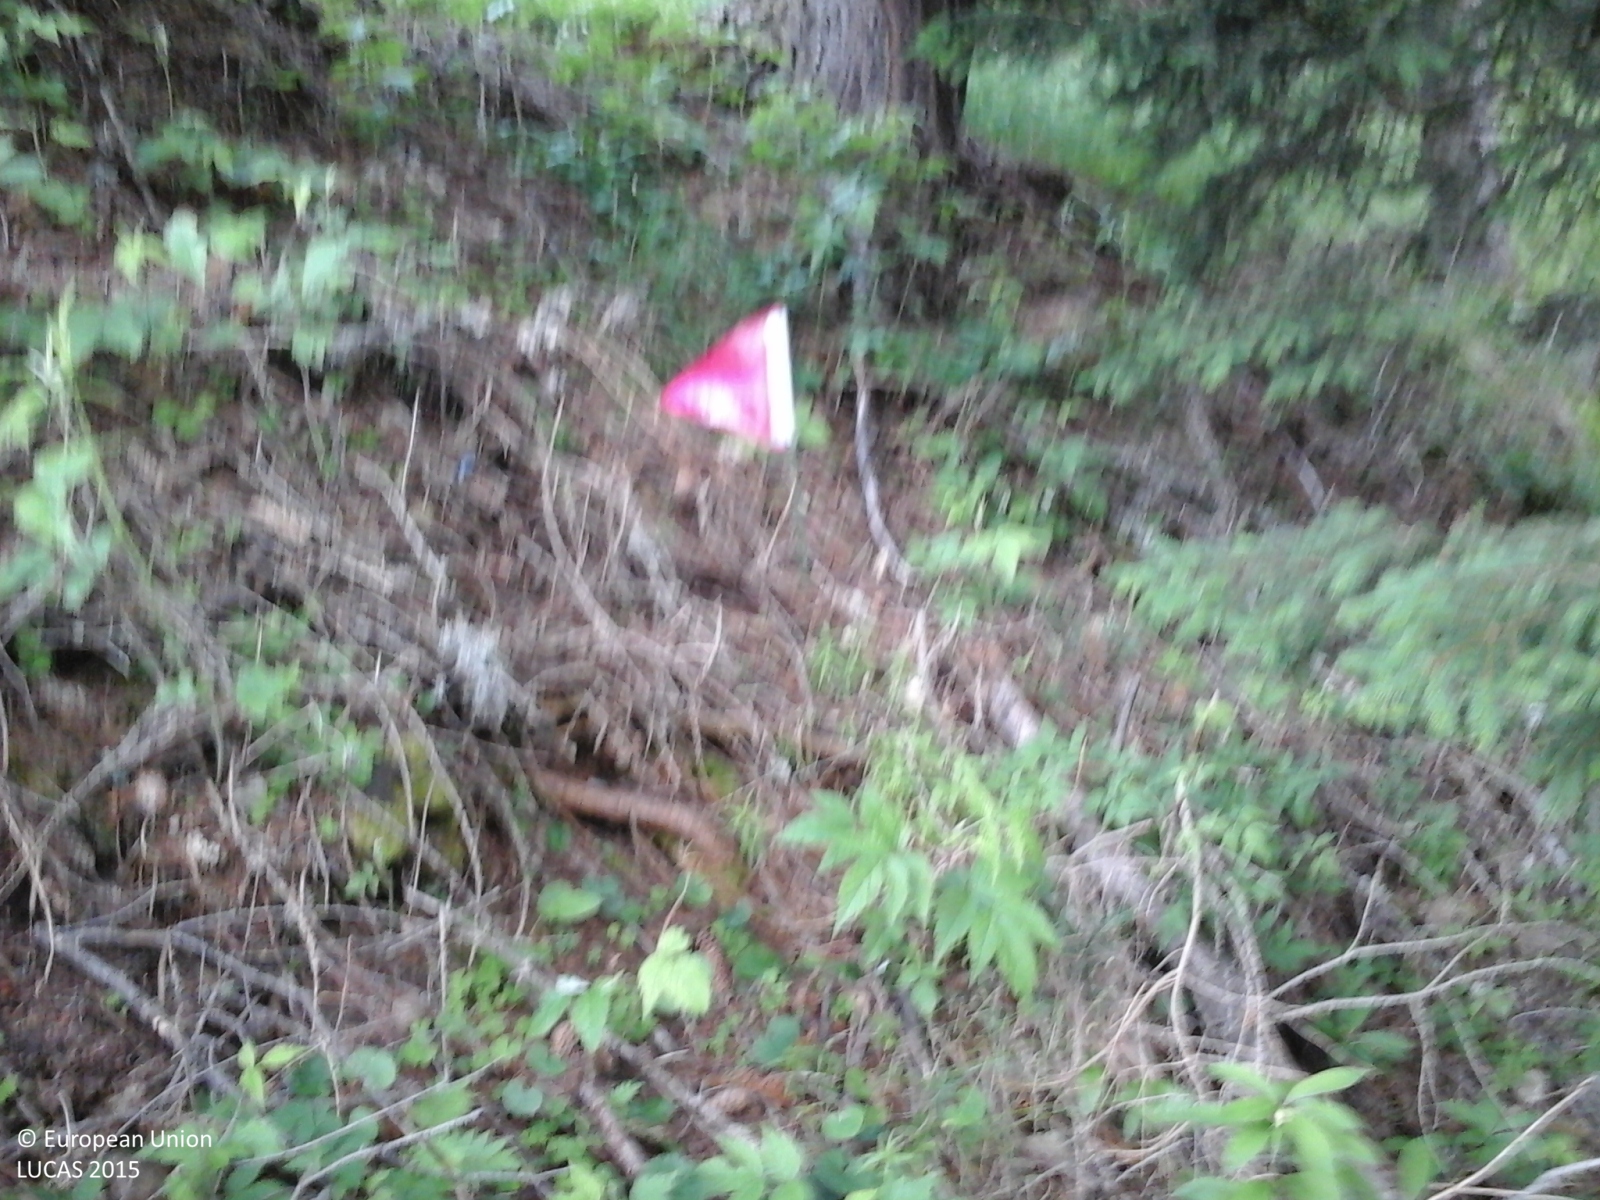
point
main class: Woodland
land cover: Spruce dominated coniferous woodland
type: alpine coniferous forest
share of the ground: > 75 %
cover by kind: coniferous forest trees 100 %
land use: Forestry
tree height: > 5 m
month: June
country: IT
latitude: 46.5529
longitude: 11.7588
